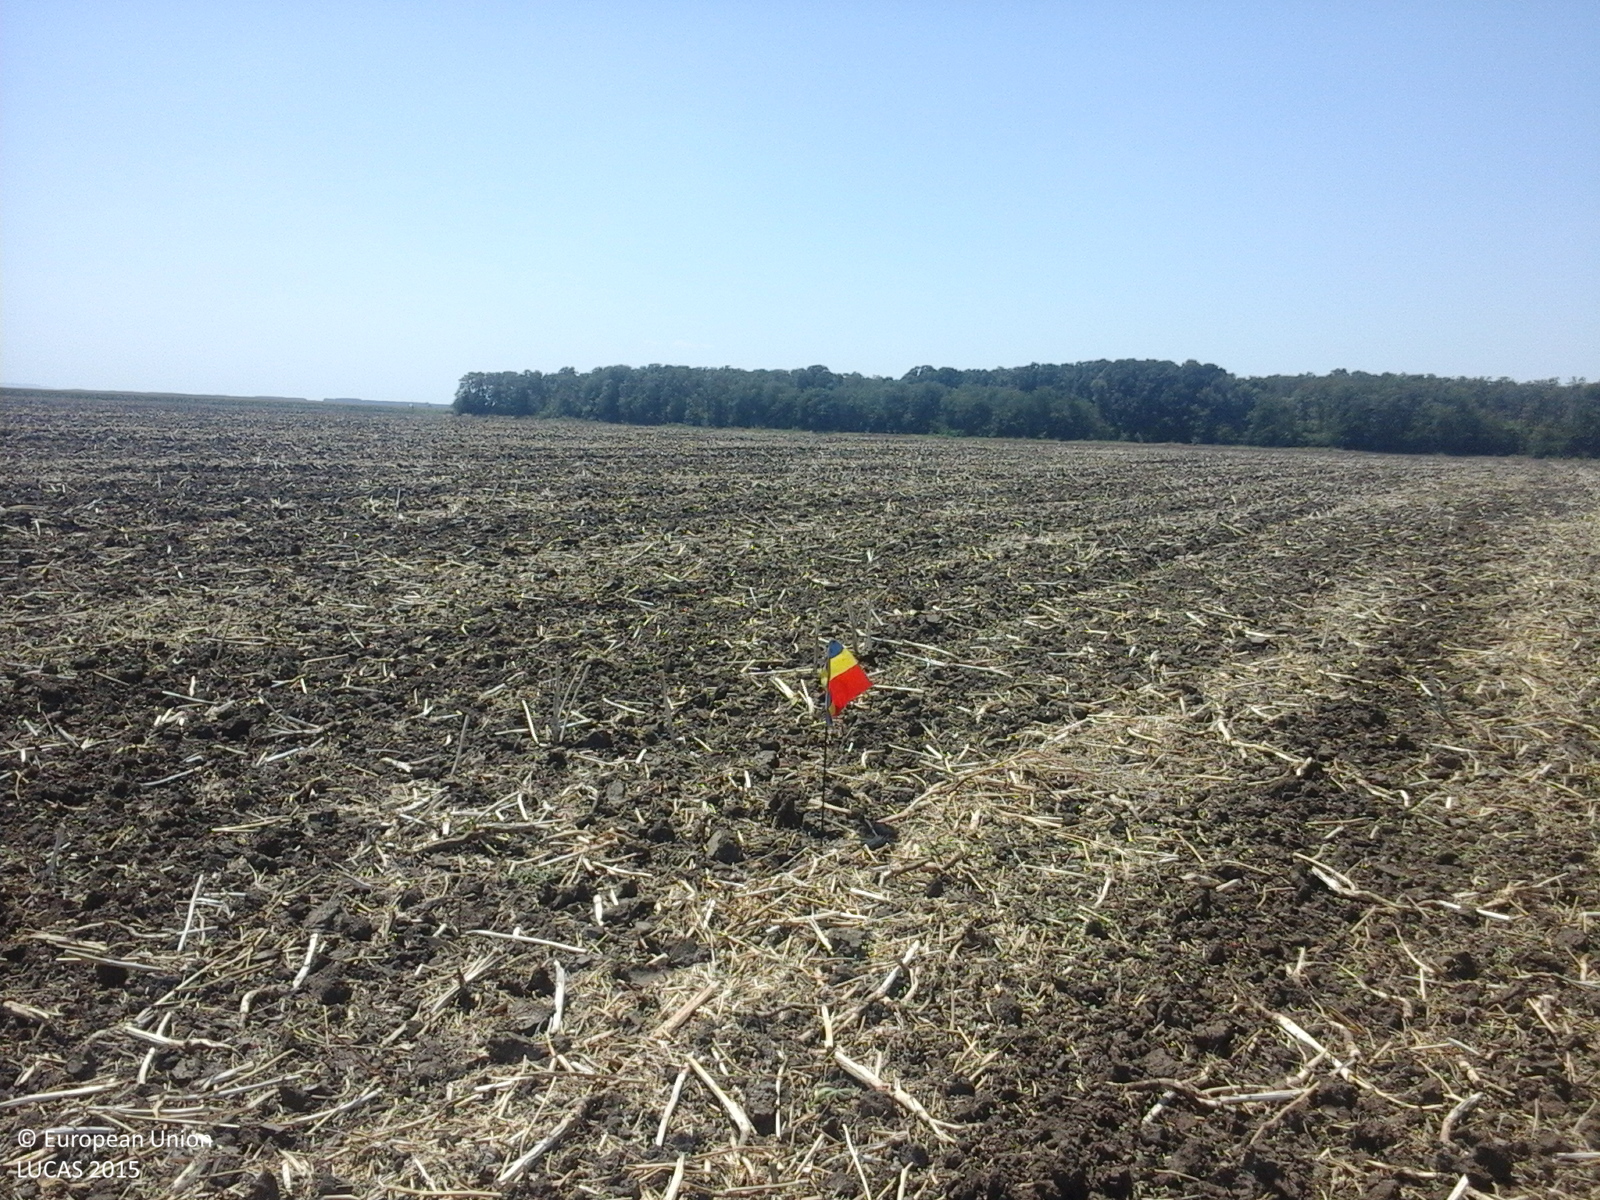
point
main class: Cropland
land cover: Rape and turnip rape
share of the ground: < 10 %
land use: Agriculture (excluding fallow land and kitchen gardens)
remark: Harvested field
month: July
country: RO
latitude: 44.1861
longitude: 26.6674
